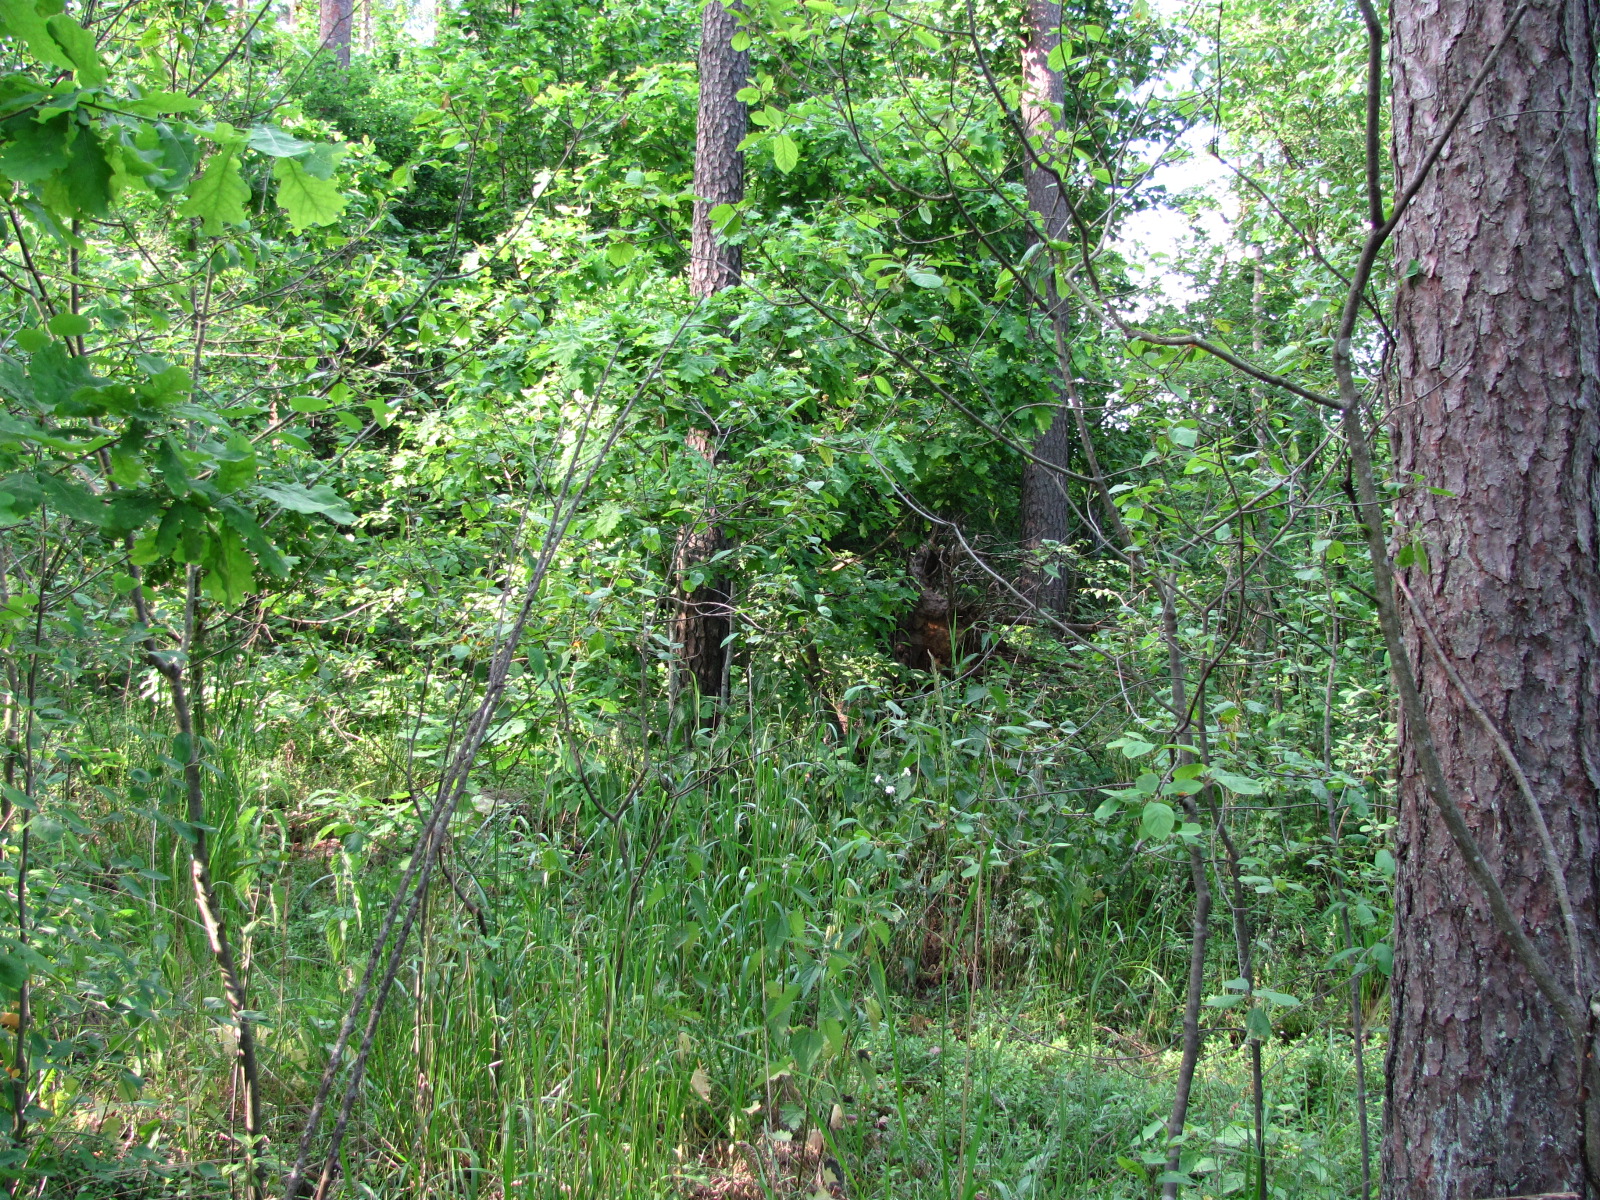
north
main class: Woodland
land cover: Pine dominated mixed woodland
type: hemiboreal forest and nemoral coniferous forest and mixed broadleaved-coniferous forest
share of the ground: > 75 %
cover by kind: coniferous forest trees 60 %, broadleaved forest trees 30 %, herbaceous plants 10 %
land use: Forestry
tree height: > 5 m
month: June
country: LV
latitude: 56.9323
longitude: 24.3376
